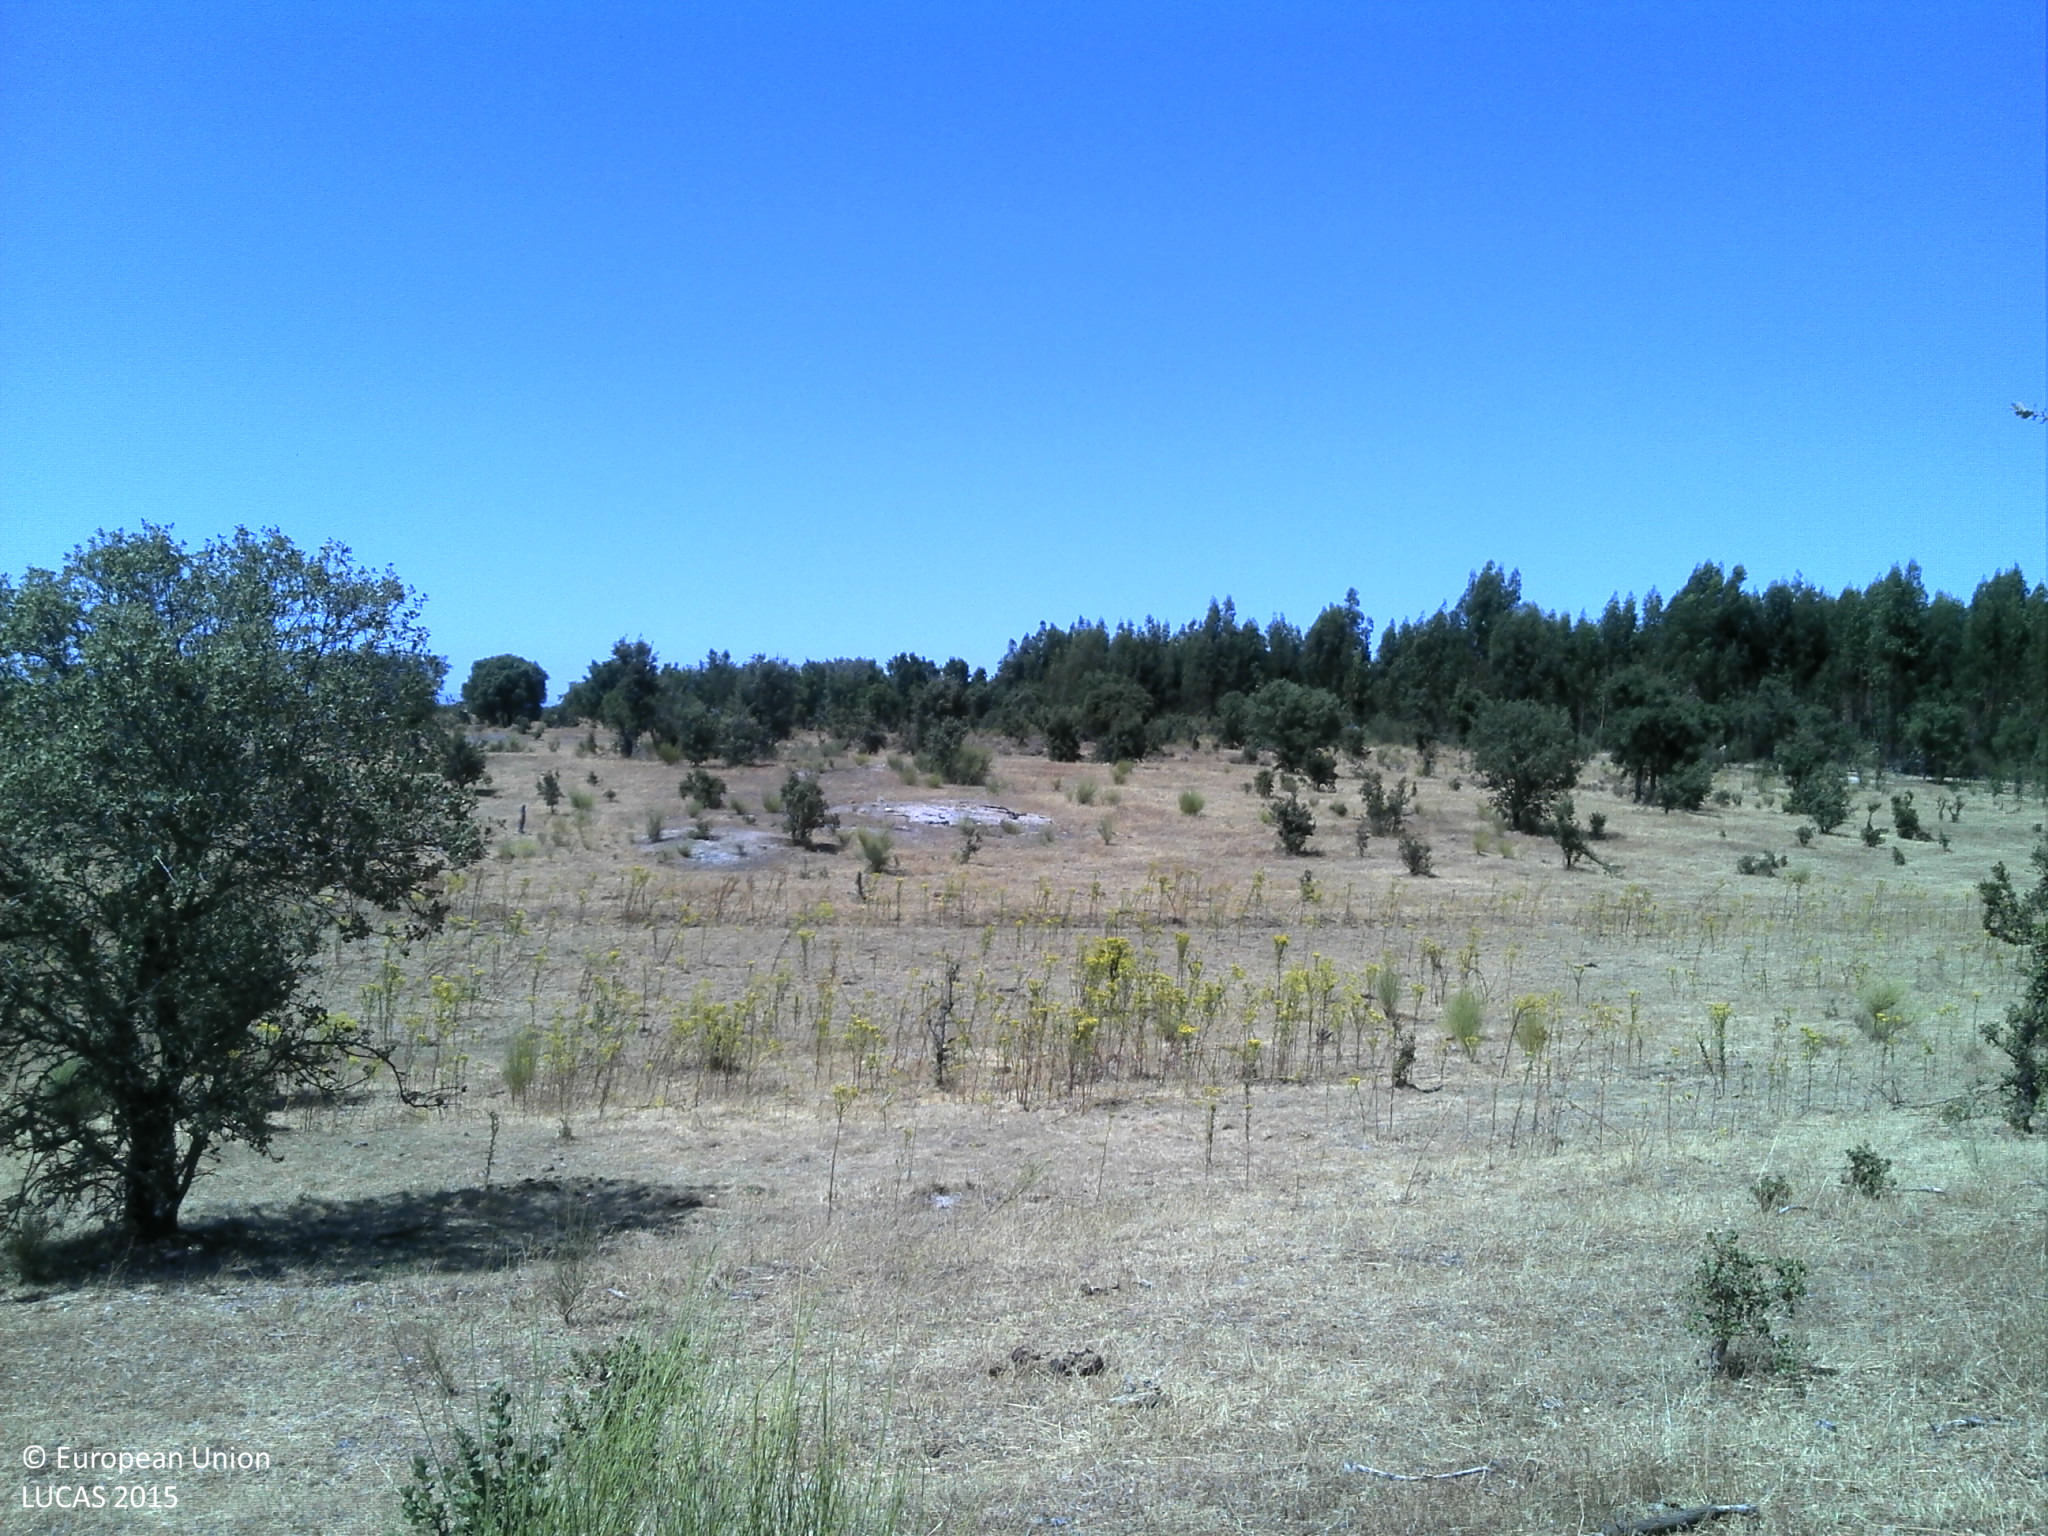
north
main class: Woodland
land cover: Broadleaved woodland
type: broadleaved evergreen forest
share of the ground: 10 - 25 %
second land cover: Grassland without tree/shrub cover
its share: 10 - 25 %
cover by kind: unconsolidated bare surface 75 %, broadleaved forest trees 10 %, herbaceous plants 10 %, shrubs 5 %
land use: Forestry
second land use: Agriculture (excluding fallow land and kitchen gardens)
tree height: > 5 m
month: July
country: PT
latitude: 39.3676
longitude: -7.6798
